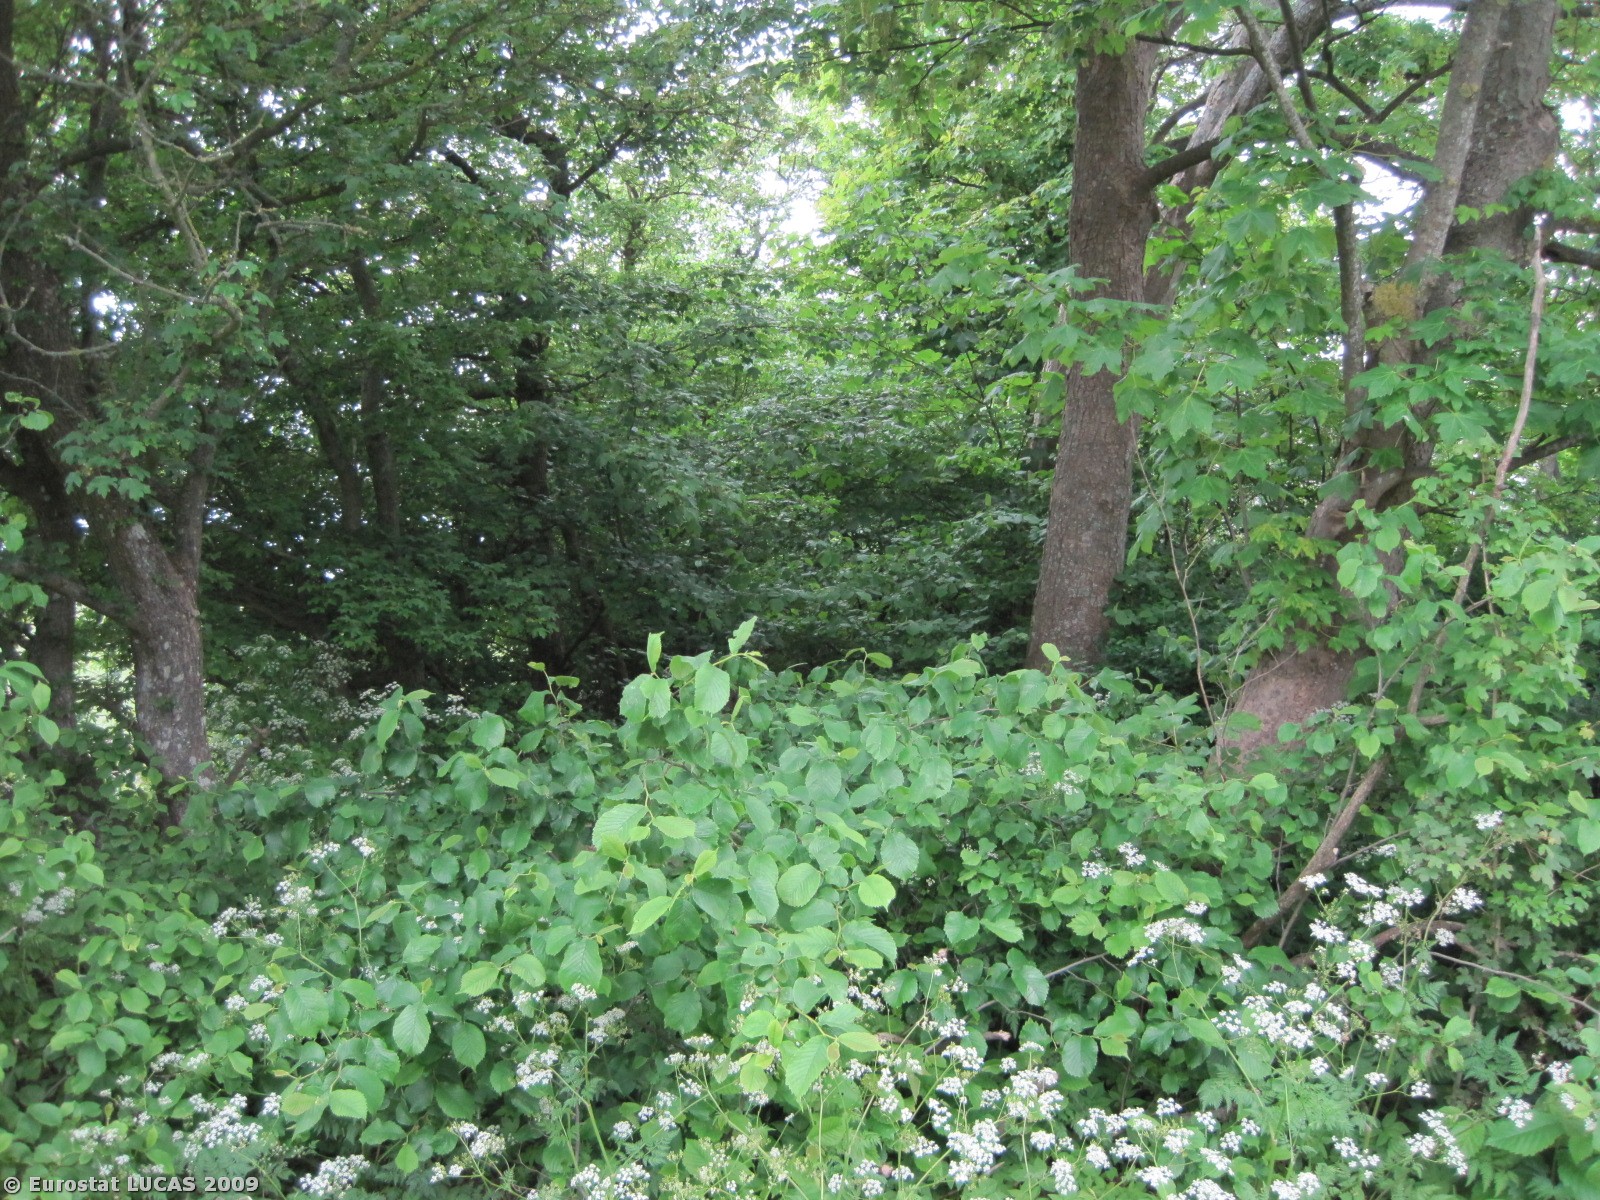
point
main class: Woodland
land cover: Broadleaved woodland
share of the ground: > 75 %
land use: Residential
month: May
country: DK
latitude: 56.7090
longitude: 10.0816
